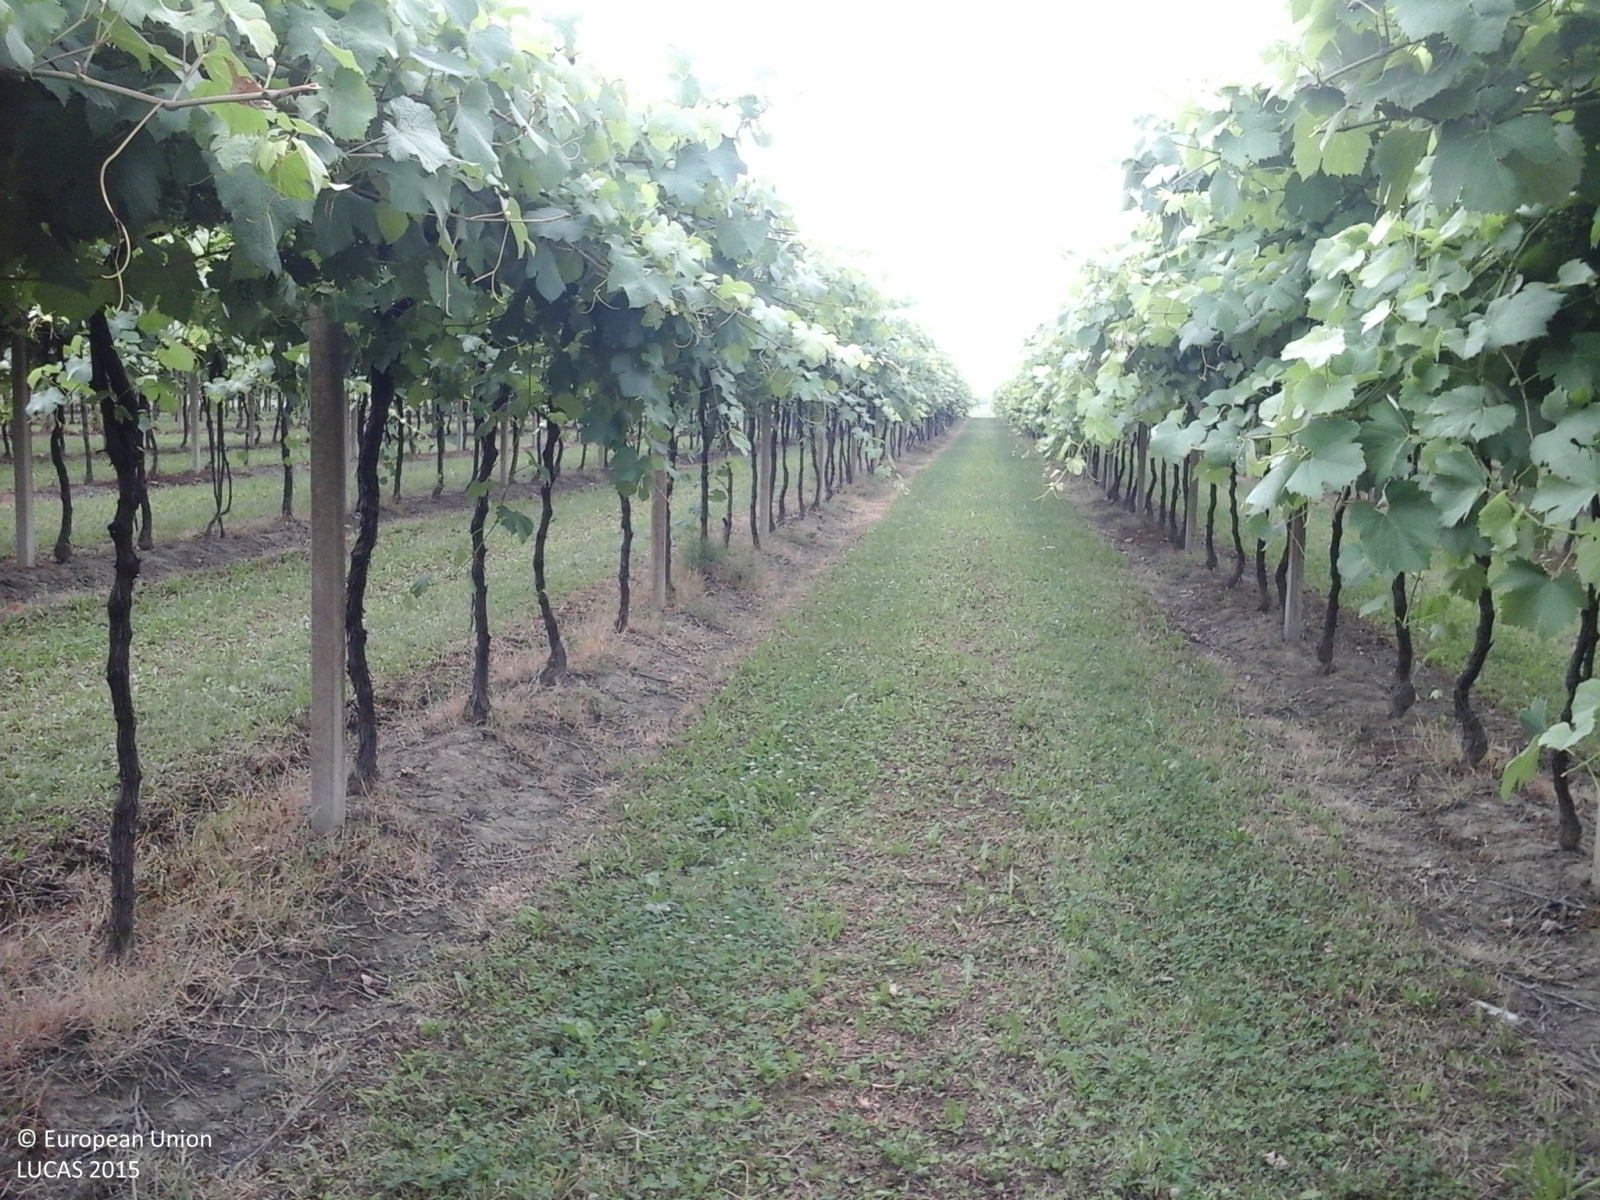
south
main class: Cropland
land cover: Vineyards
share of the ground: 50 - 75 %
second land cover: Grassland without tree/shrub cover
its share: > 75 %
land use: Agriculture (excluding fallow land and kitchen gardens)
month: June
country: IT
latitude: 44.7062
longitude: 11.0202
